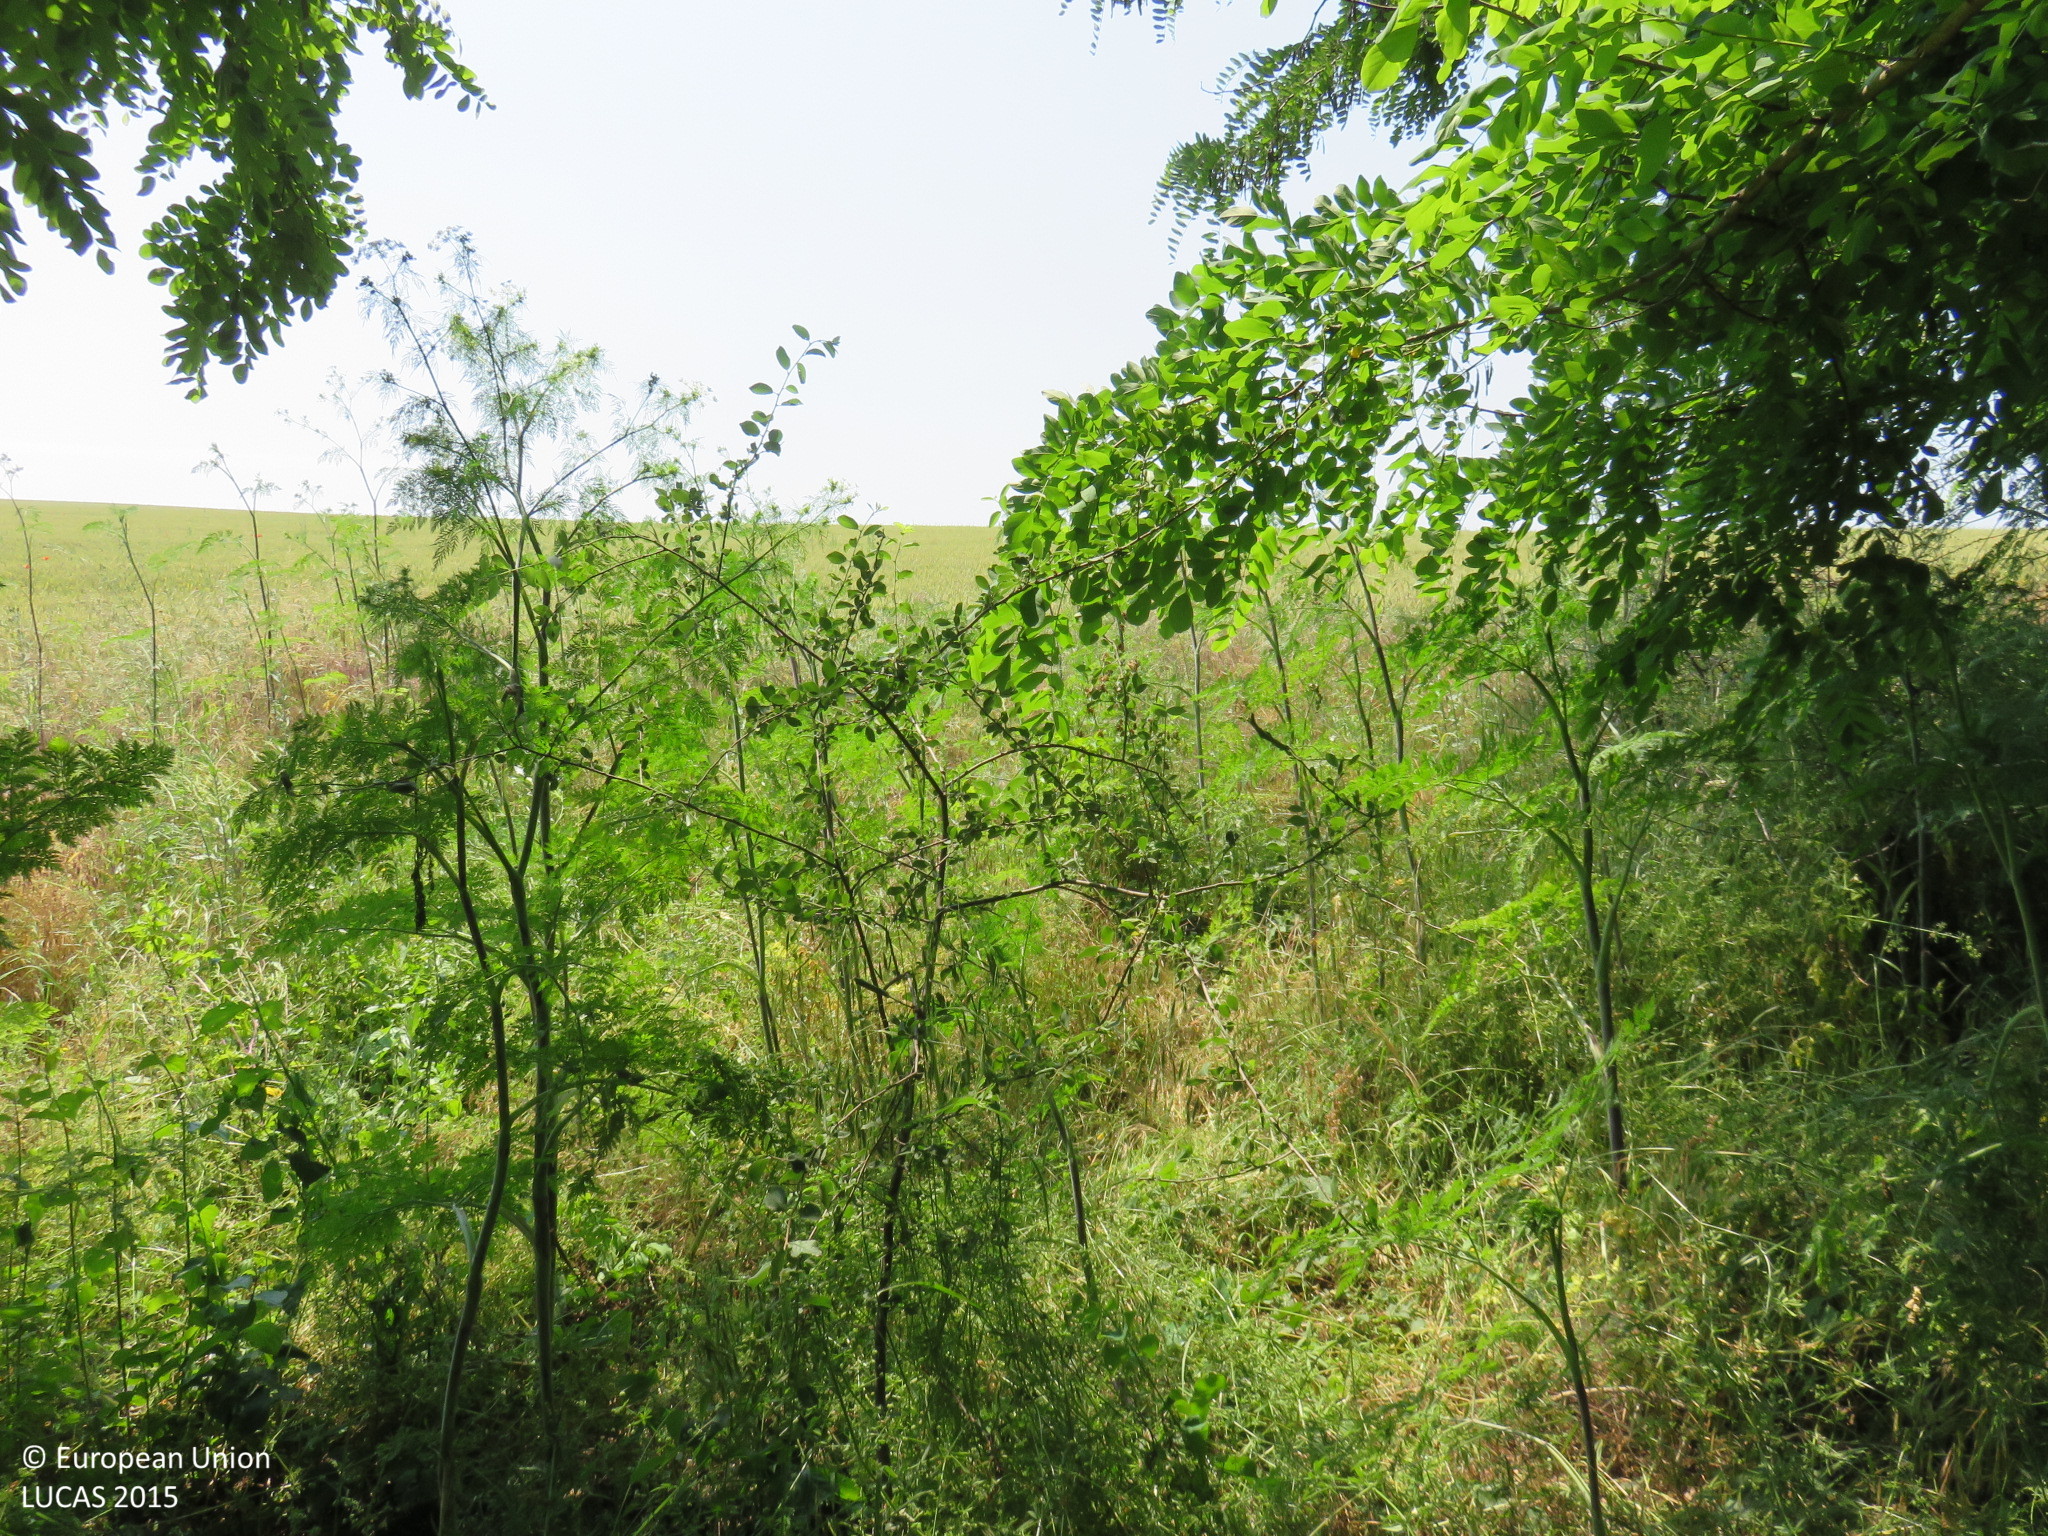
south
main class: Woodland
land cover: Broadleaved woodland
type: exotic forest
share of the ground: > 75 %
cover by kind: broadleaved forest trees 80 %, shrubs 10 %, herbaceous plants 10 %
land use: Forestry
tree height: < 5 m
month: June
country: BG
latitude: 43.3398
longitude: 24.5294
